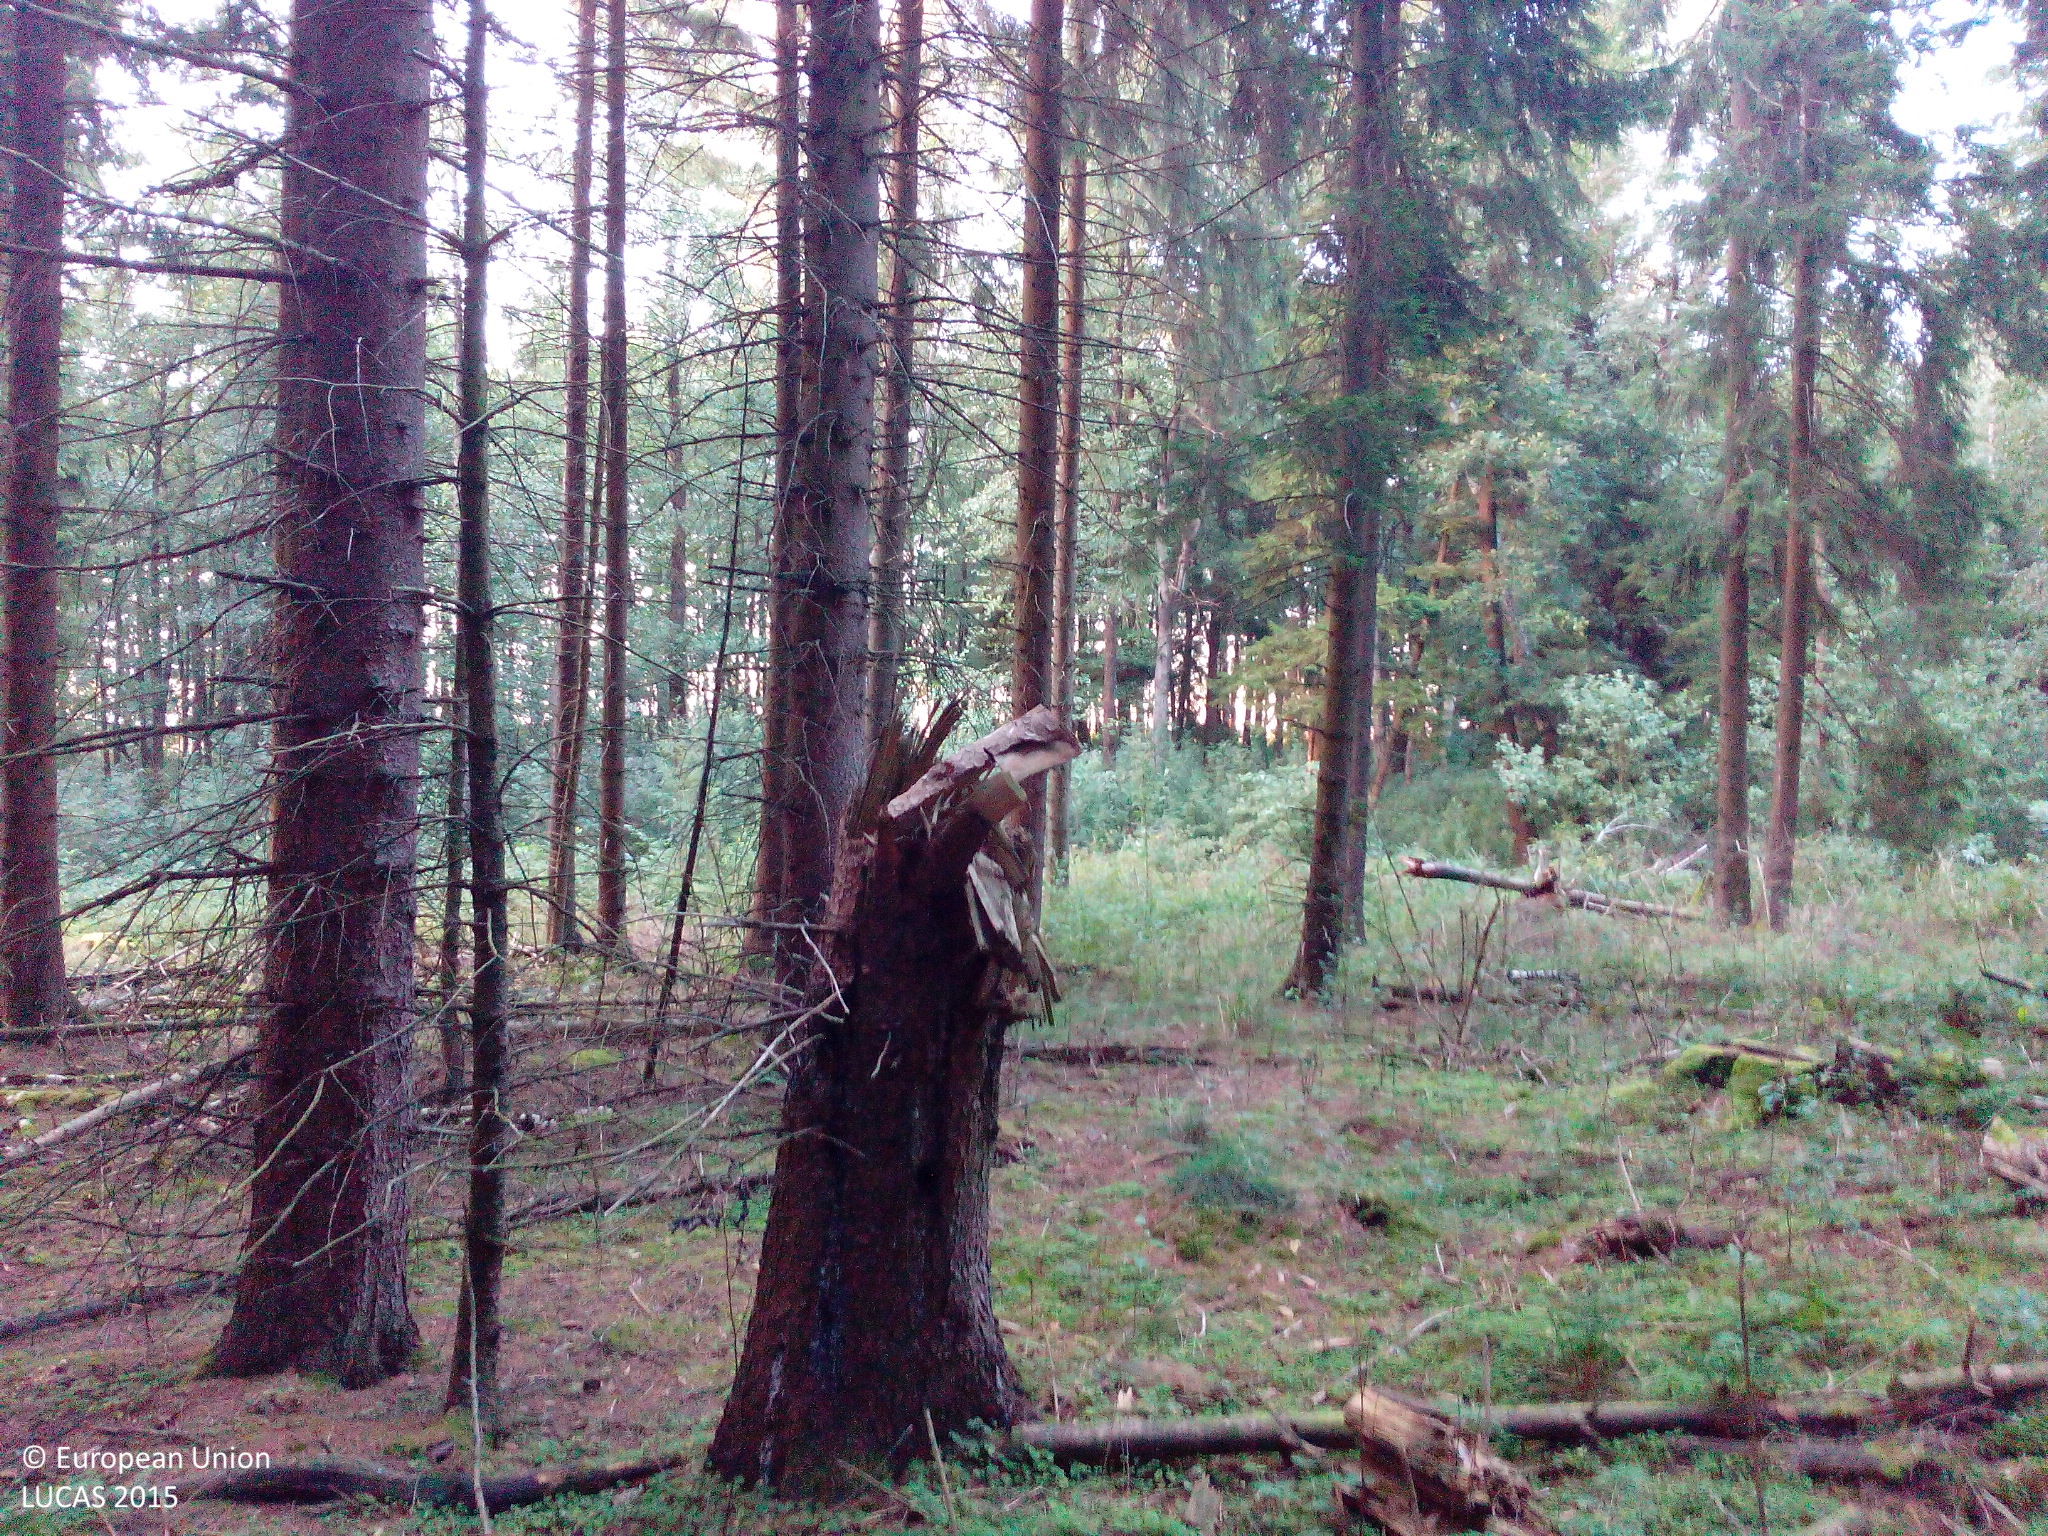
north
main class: Woodland
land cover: Spruce dominated coniferous woodland
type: hemiboreal forest and nemoral coniferous forest and mixed broadleaved-coniferous forest
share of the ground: > 75 %
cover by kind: coniferous forest trees 100 %
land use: Forestry
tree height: > 5 m
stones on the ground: < 10 %
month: September
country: DE
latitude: 51.5274
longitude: 11.1096
